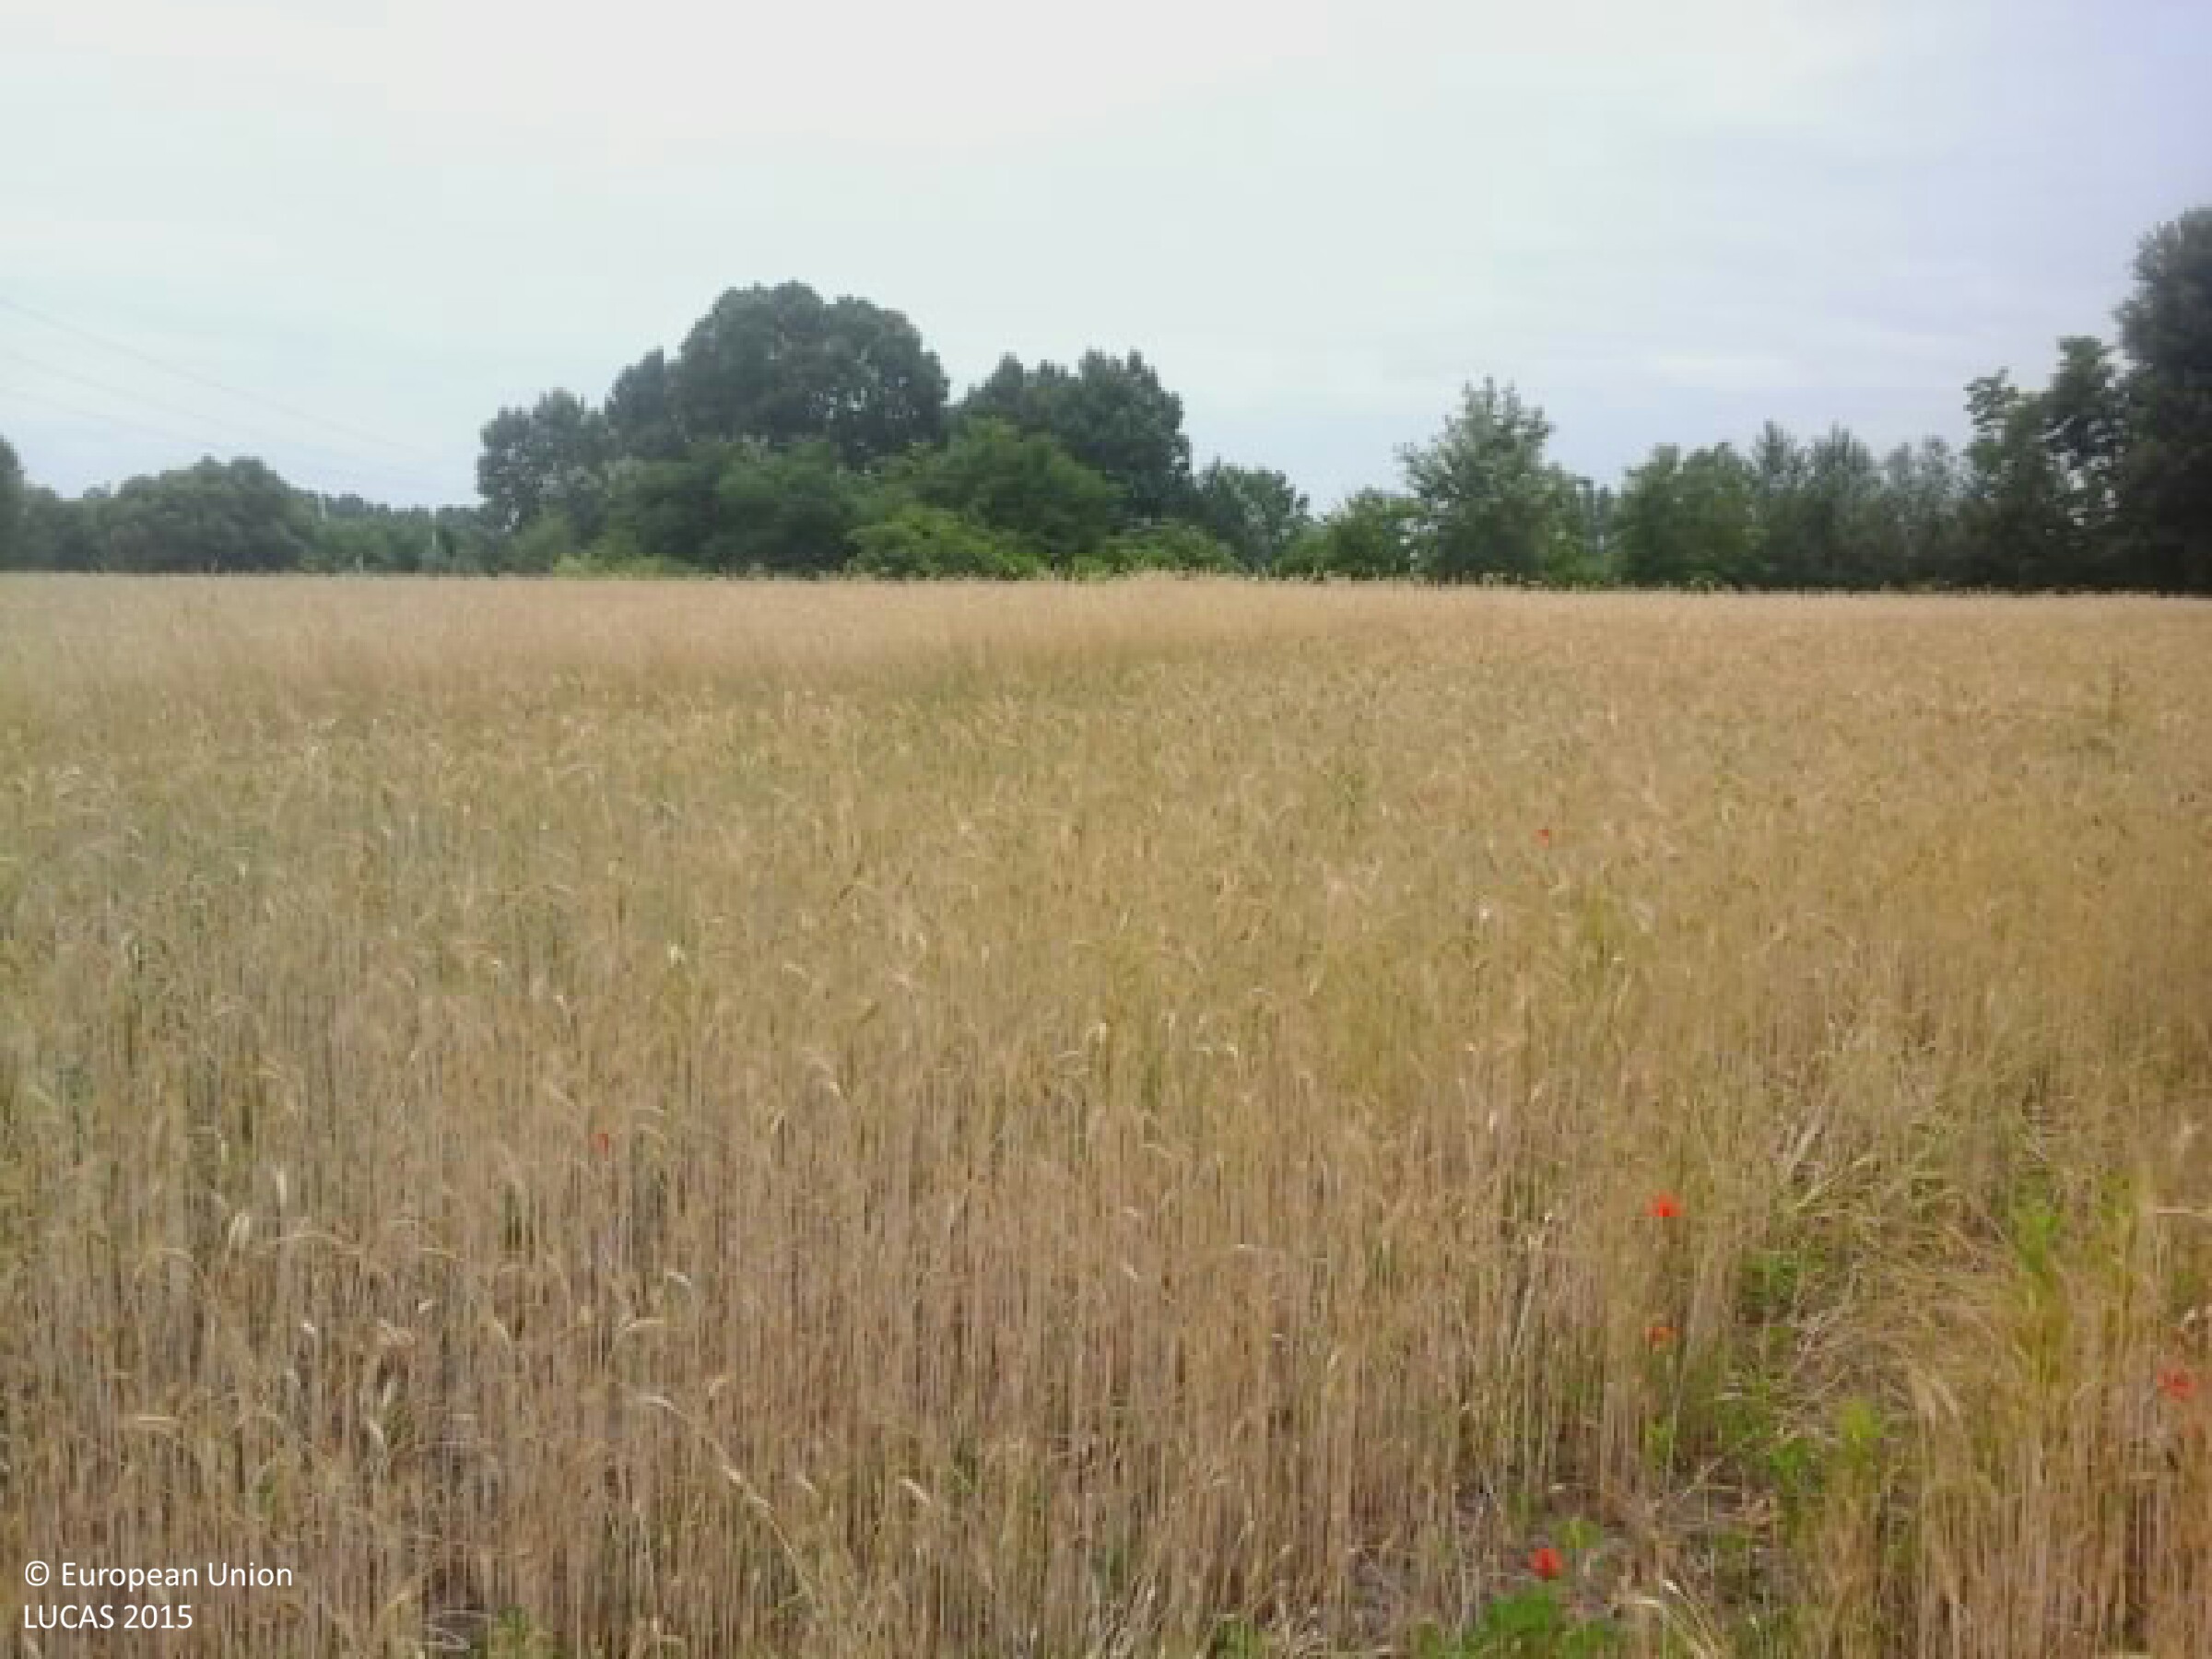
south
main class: Cropland
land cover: Common wheat
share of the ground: 10 - 25 %
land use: Agriculture (excluding fallow land and kitchen gardens)
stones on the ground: < 10 %
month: June
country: HU
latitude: 47.3364
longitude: 19.1363
